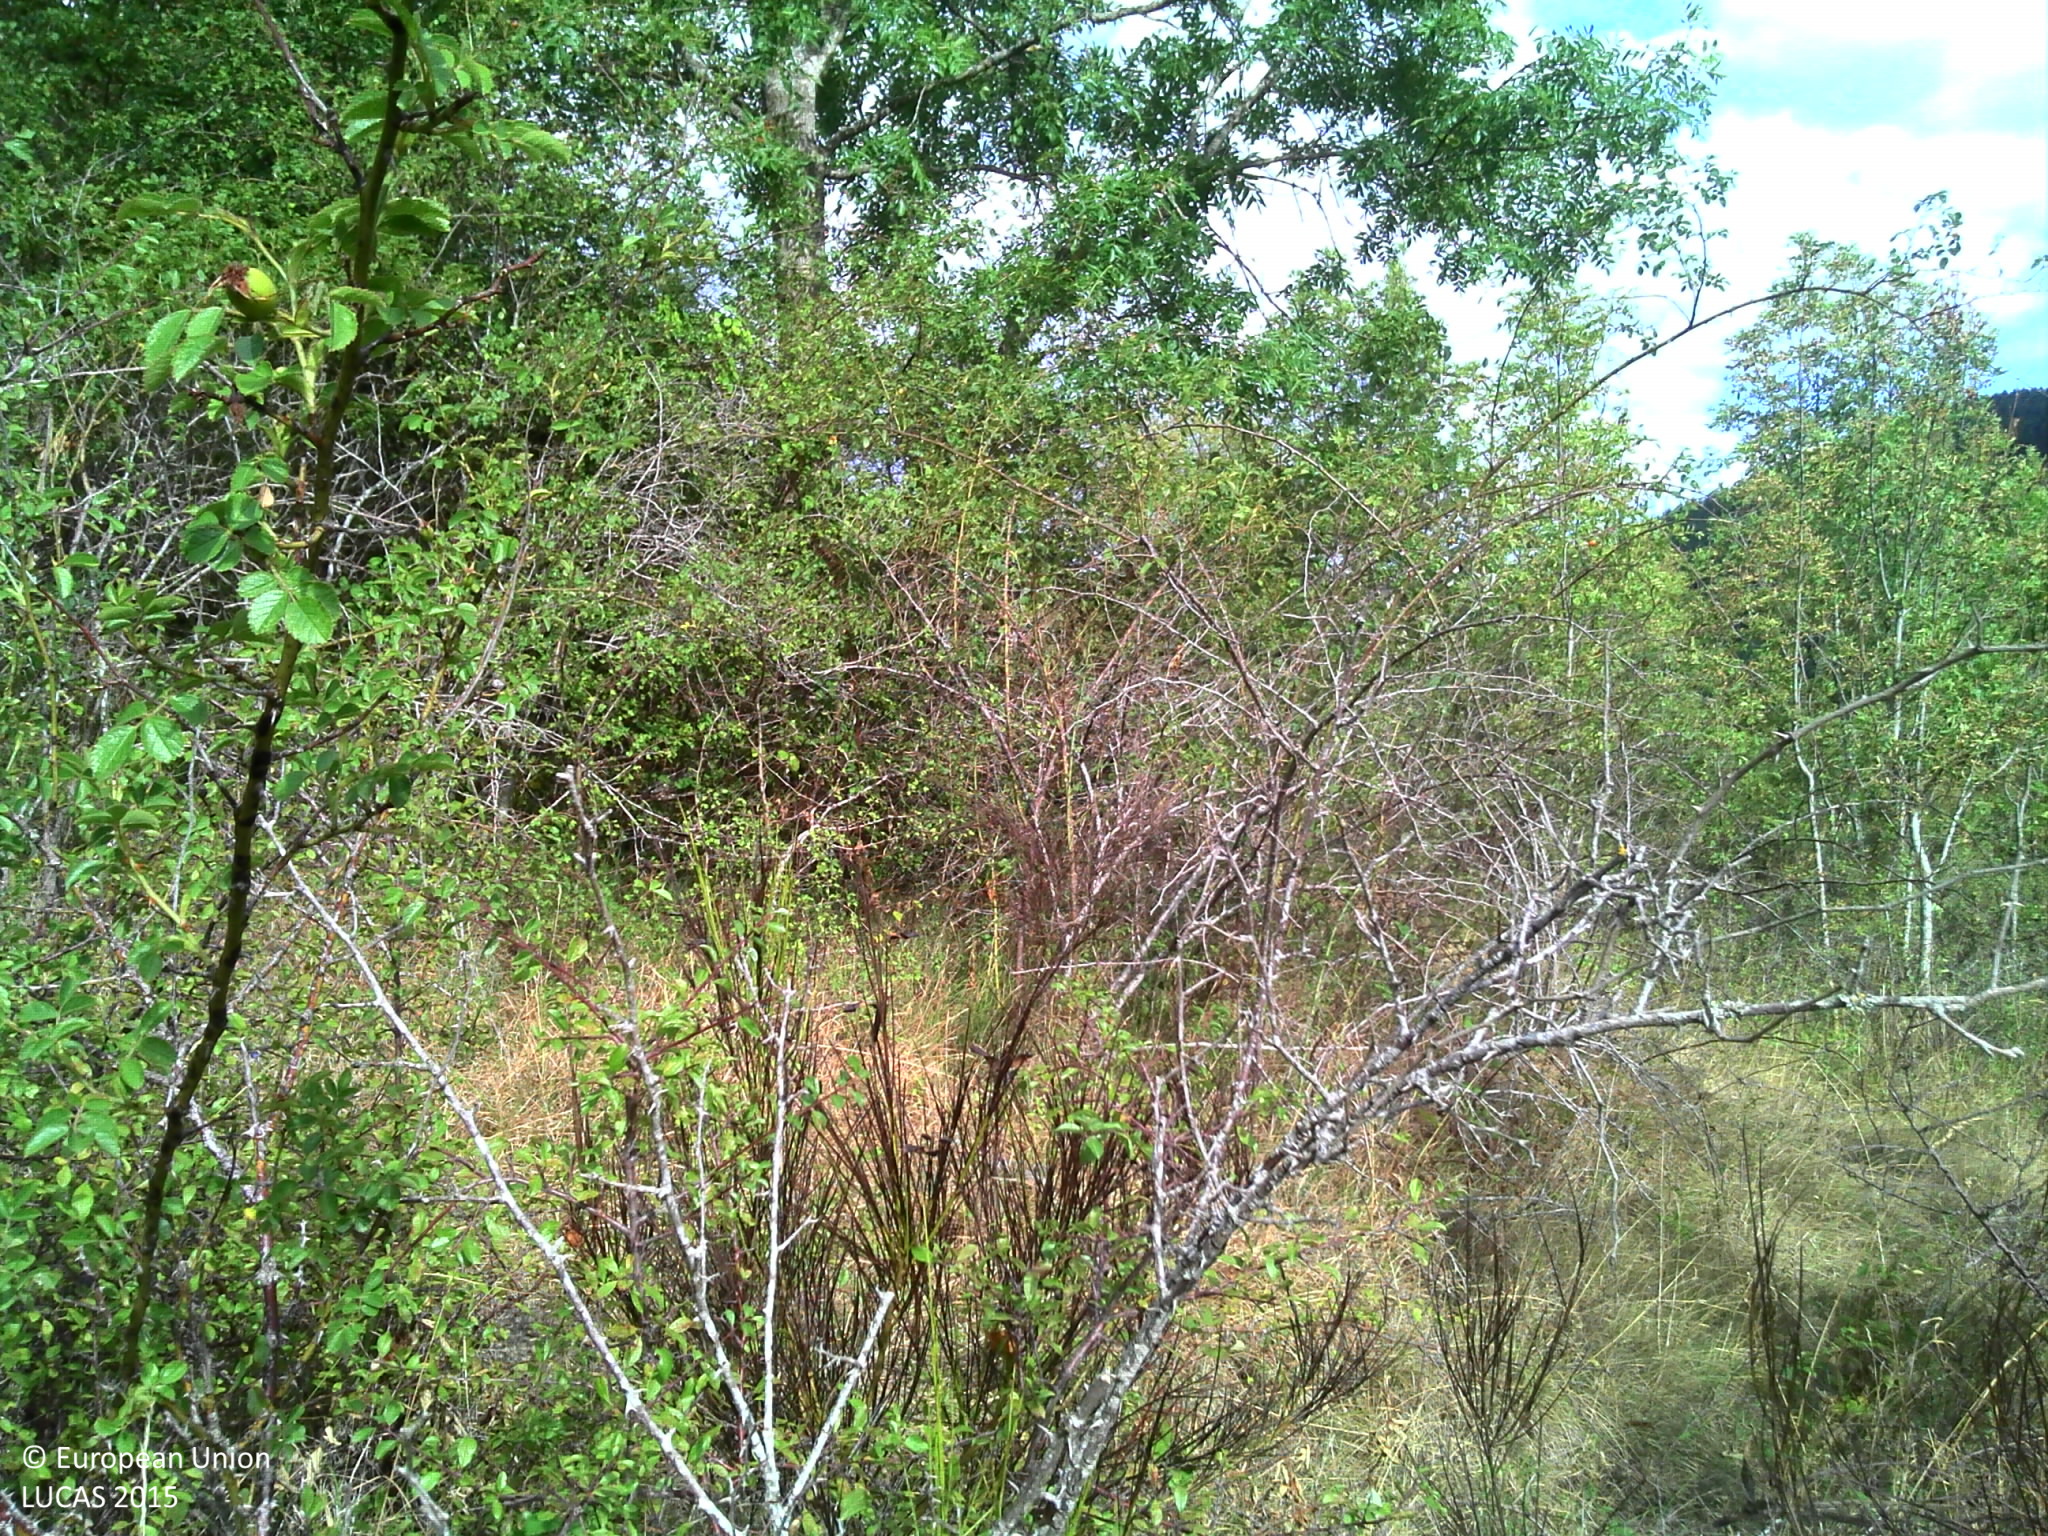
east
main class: Shrubland
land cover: Shrubland with sparse tree cover
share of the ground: > 75 %
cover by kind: shrubs 60 %, herbaceous plants 30 %, broadleaved forest trees 5 %, lichens and mosses 5 %
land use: Semi-natural and natural areas not in use
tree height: < 5 m
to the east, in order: Shrubland with sparse tree cover; Tracks; Fences; Shrubland with sparse tree cover; Rock outcrops; Grass margins; Paved roads, cycling and walking lanes; Grass margins; Electric lines; Broadleaved woodland
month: August
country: FR
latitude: 46.0311
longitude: 4.5375
